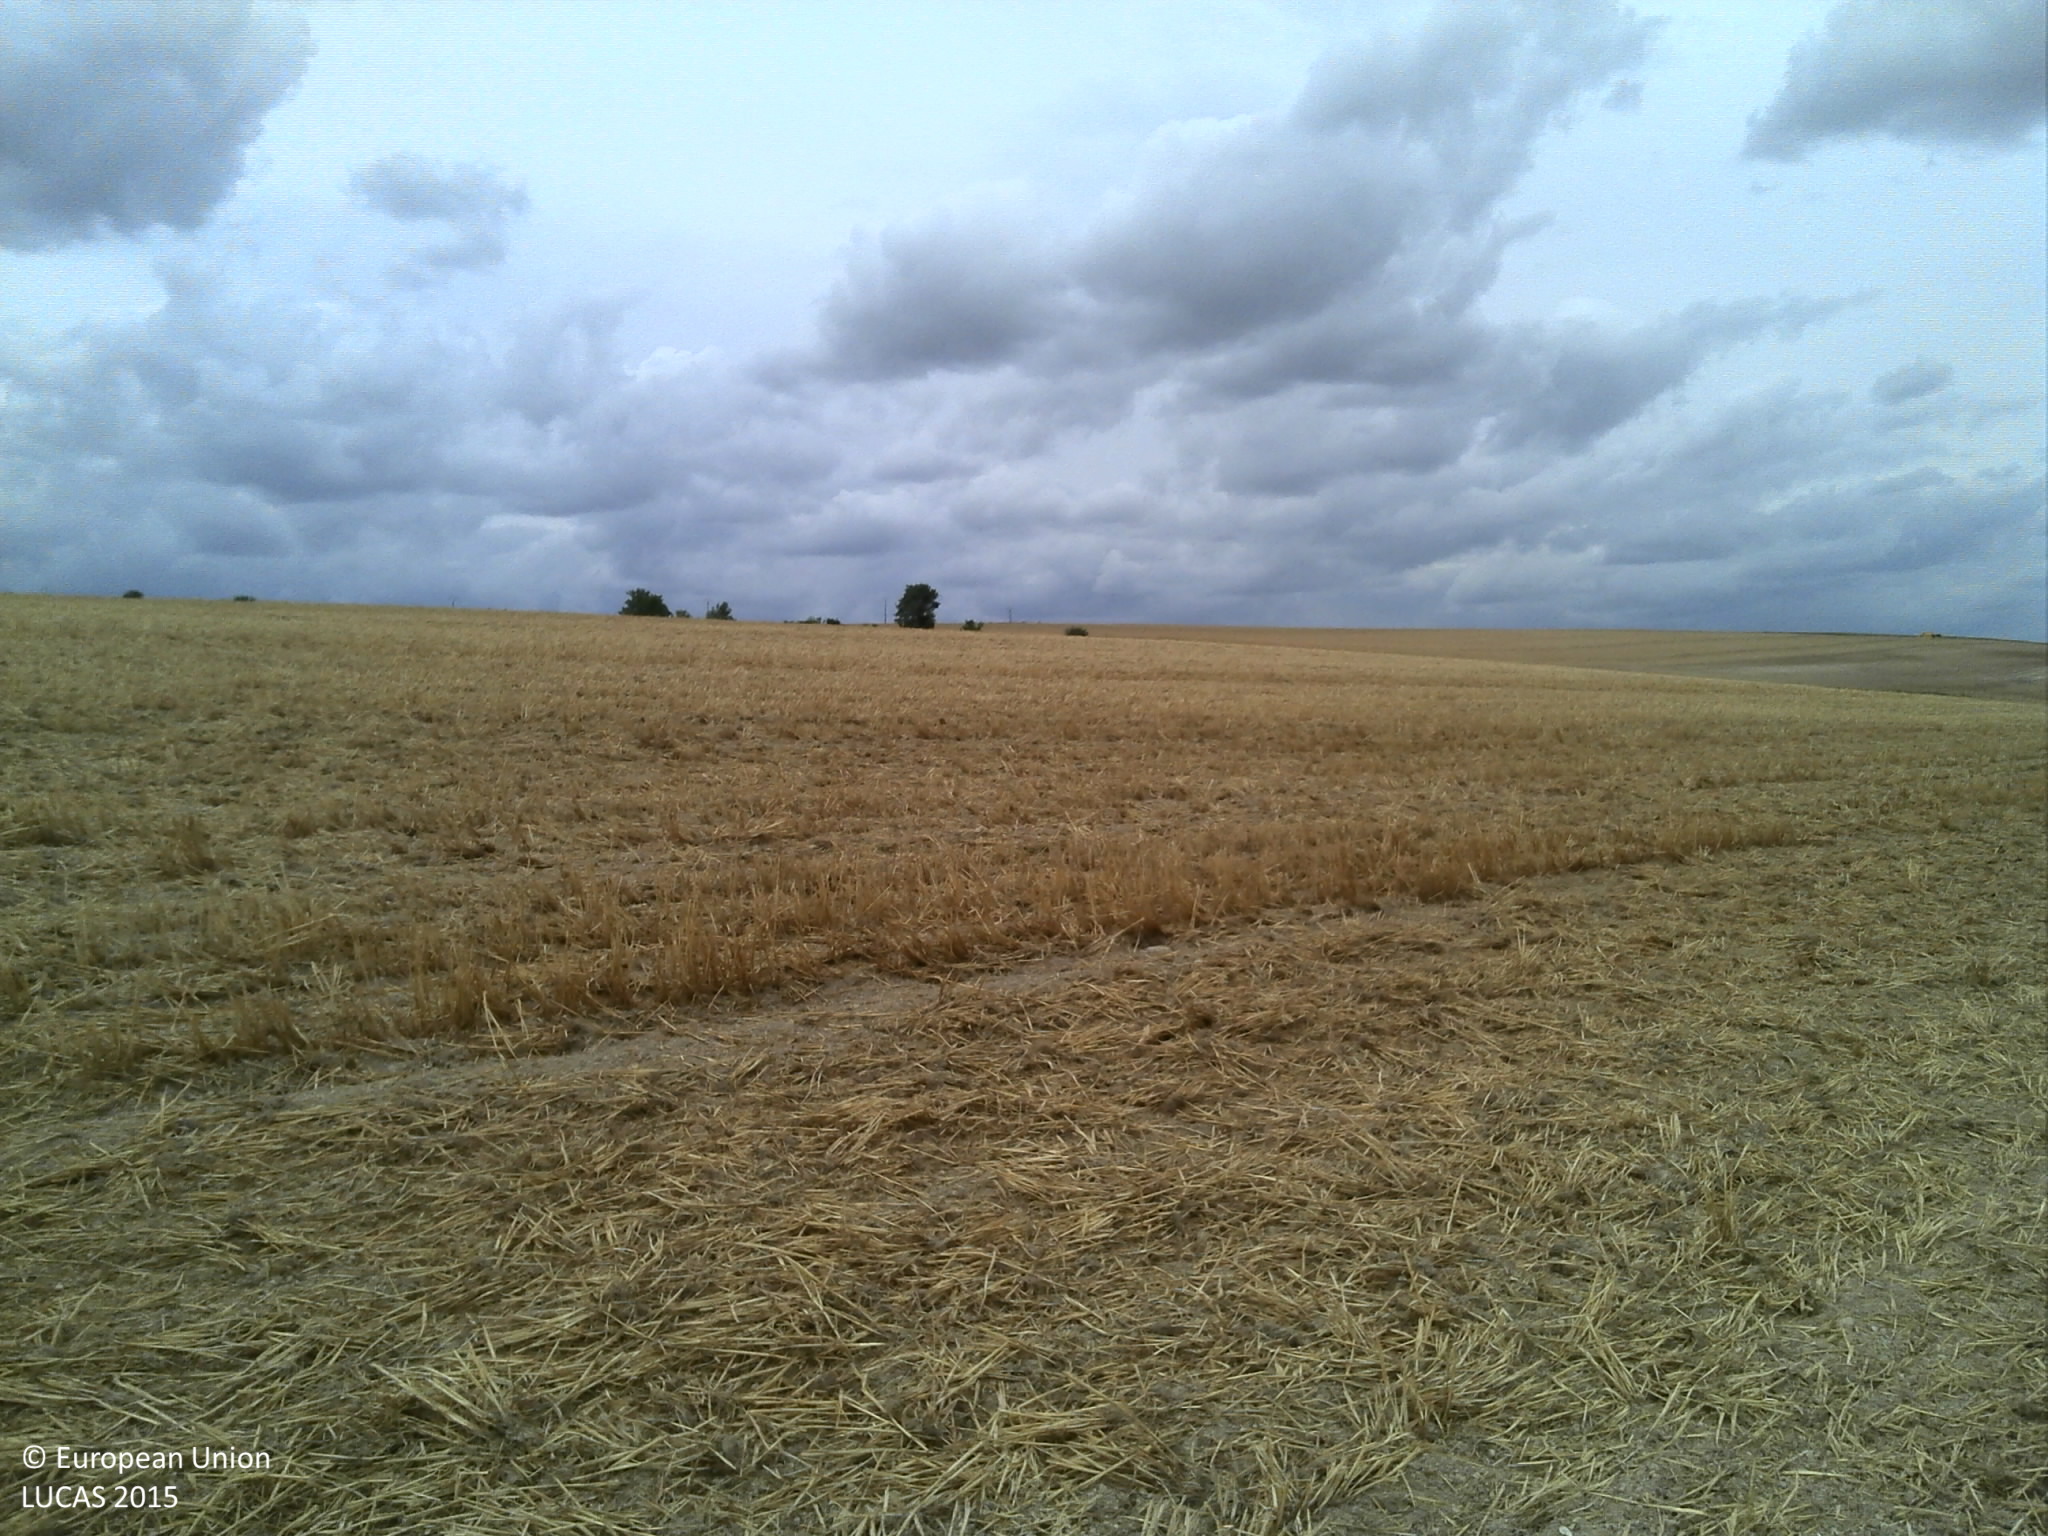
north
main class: Cropland
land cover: Common wheat
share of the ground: 25 - 50 %
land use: Agriculture (excluding fallow land and kitchen gardens)
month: July
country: FR
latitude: 49.5980
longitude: 4.0871
